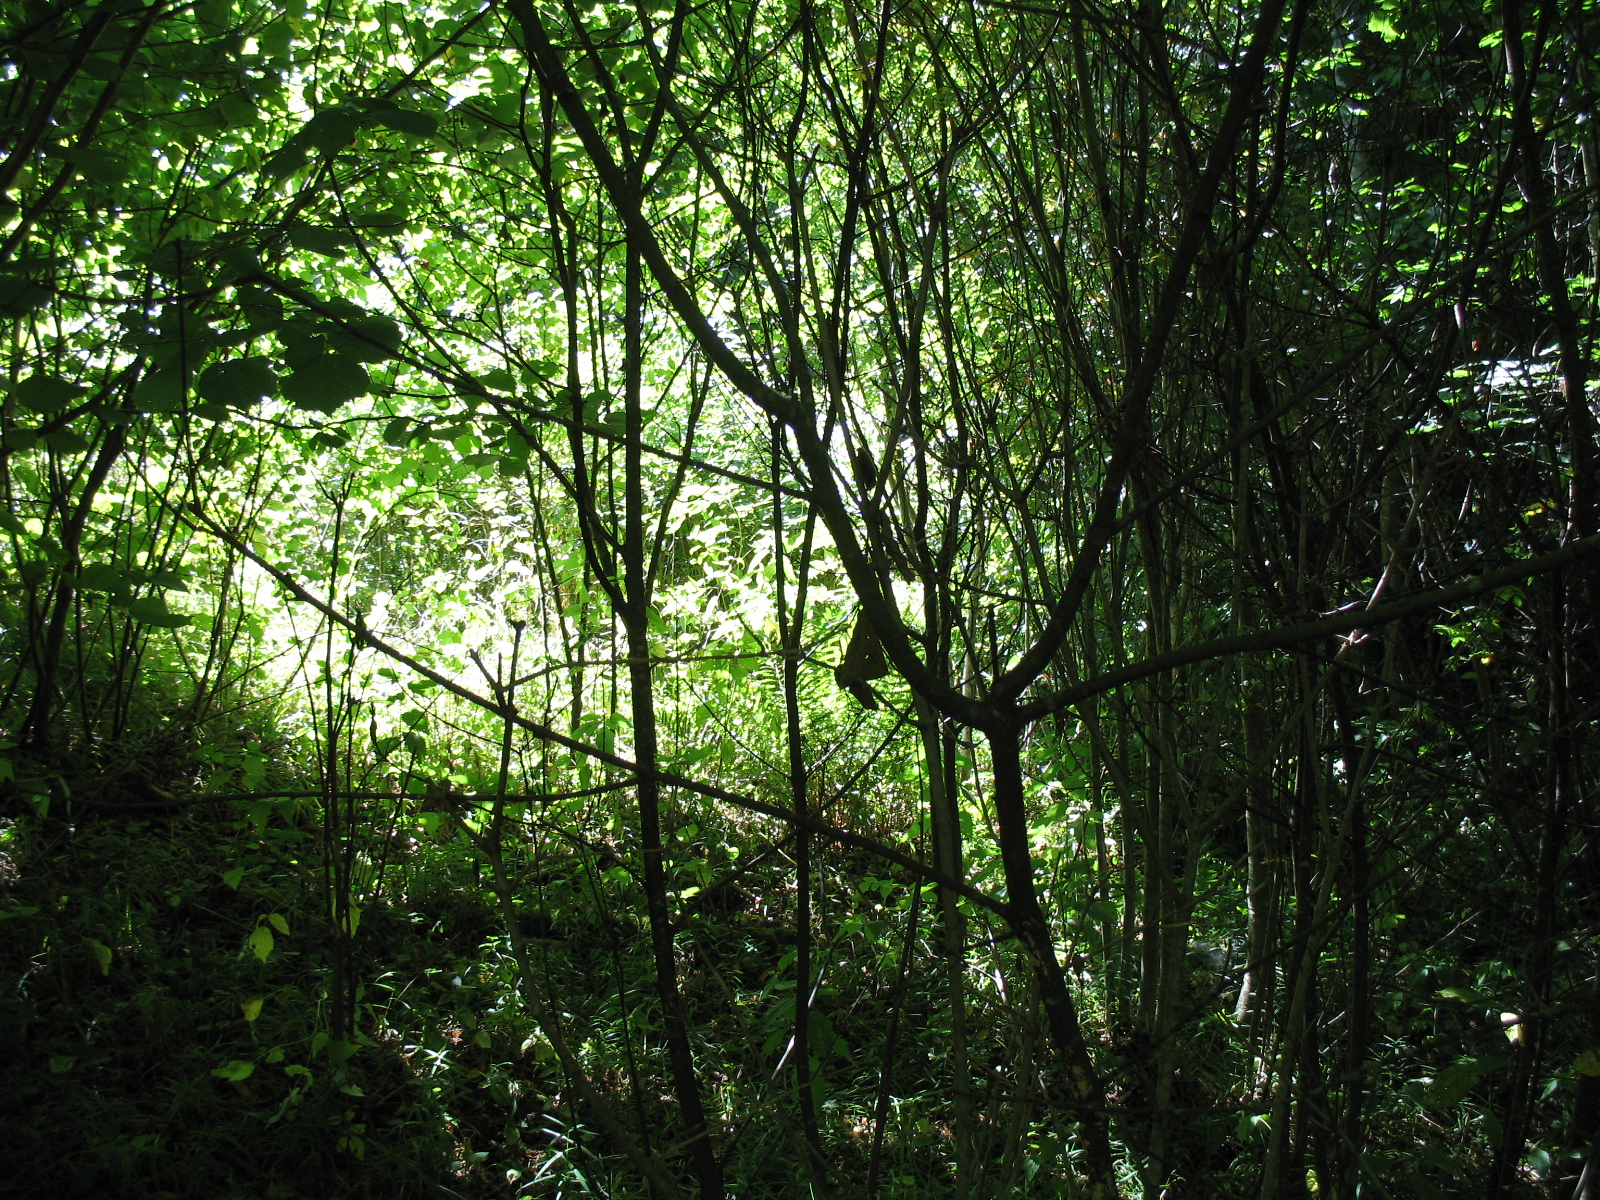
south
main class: Woodland
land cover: Broadleaved woodland
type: non-riverine alder, birch or aspen forest
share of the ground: 50 - 75 %
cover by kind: broadleaved forest trees 70 %, herbaceous plants 25 %, shrubs 5 %
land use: Forestry
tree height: > 5 m
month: August
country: LV
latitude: 56.5362
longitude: 25.6865
